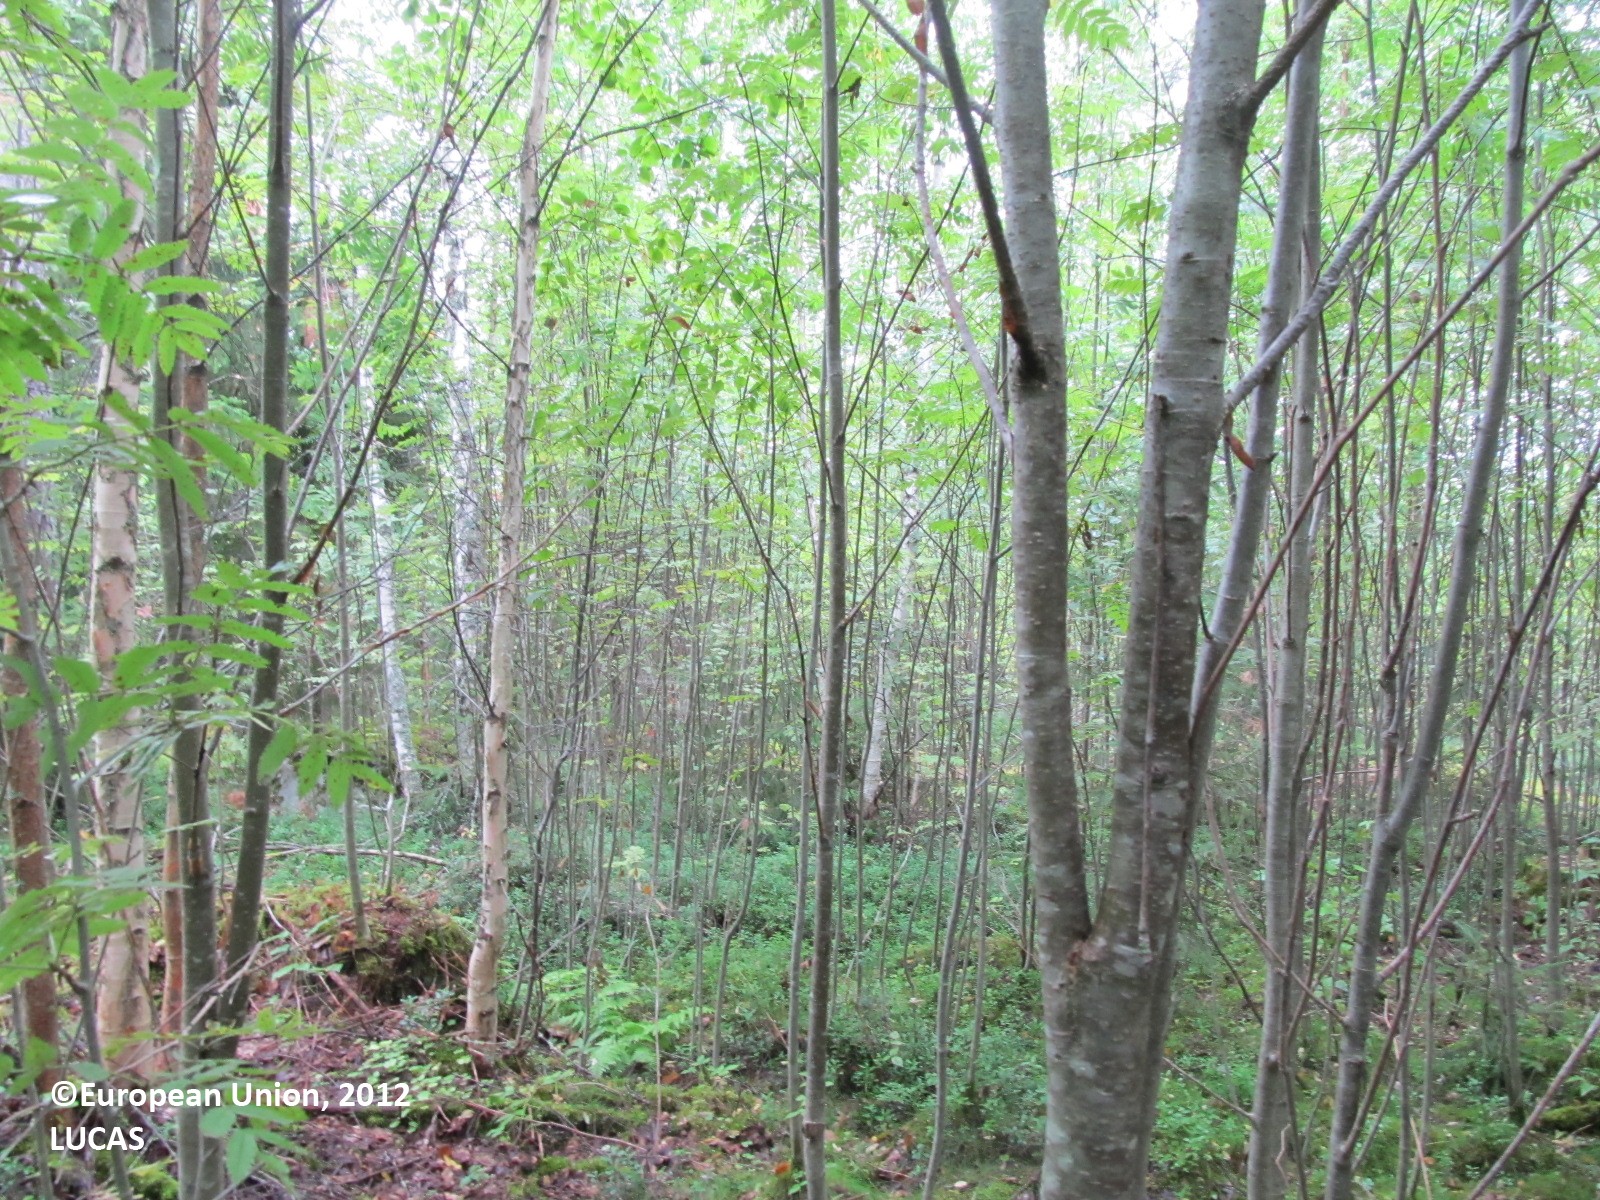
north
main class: Woodland
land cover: Broadleaved woodland
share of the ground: > 75 %
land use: Forestry
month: August
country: FI
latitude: 62.1306
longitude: 27.9625
